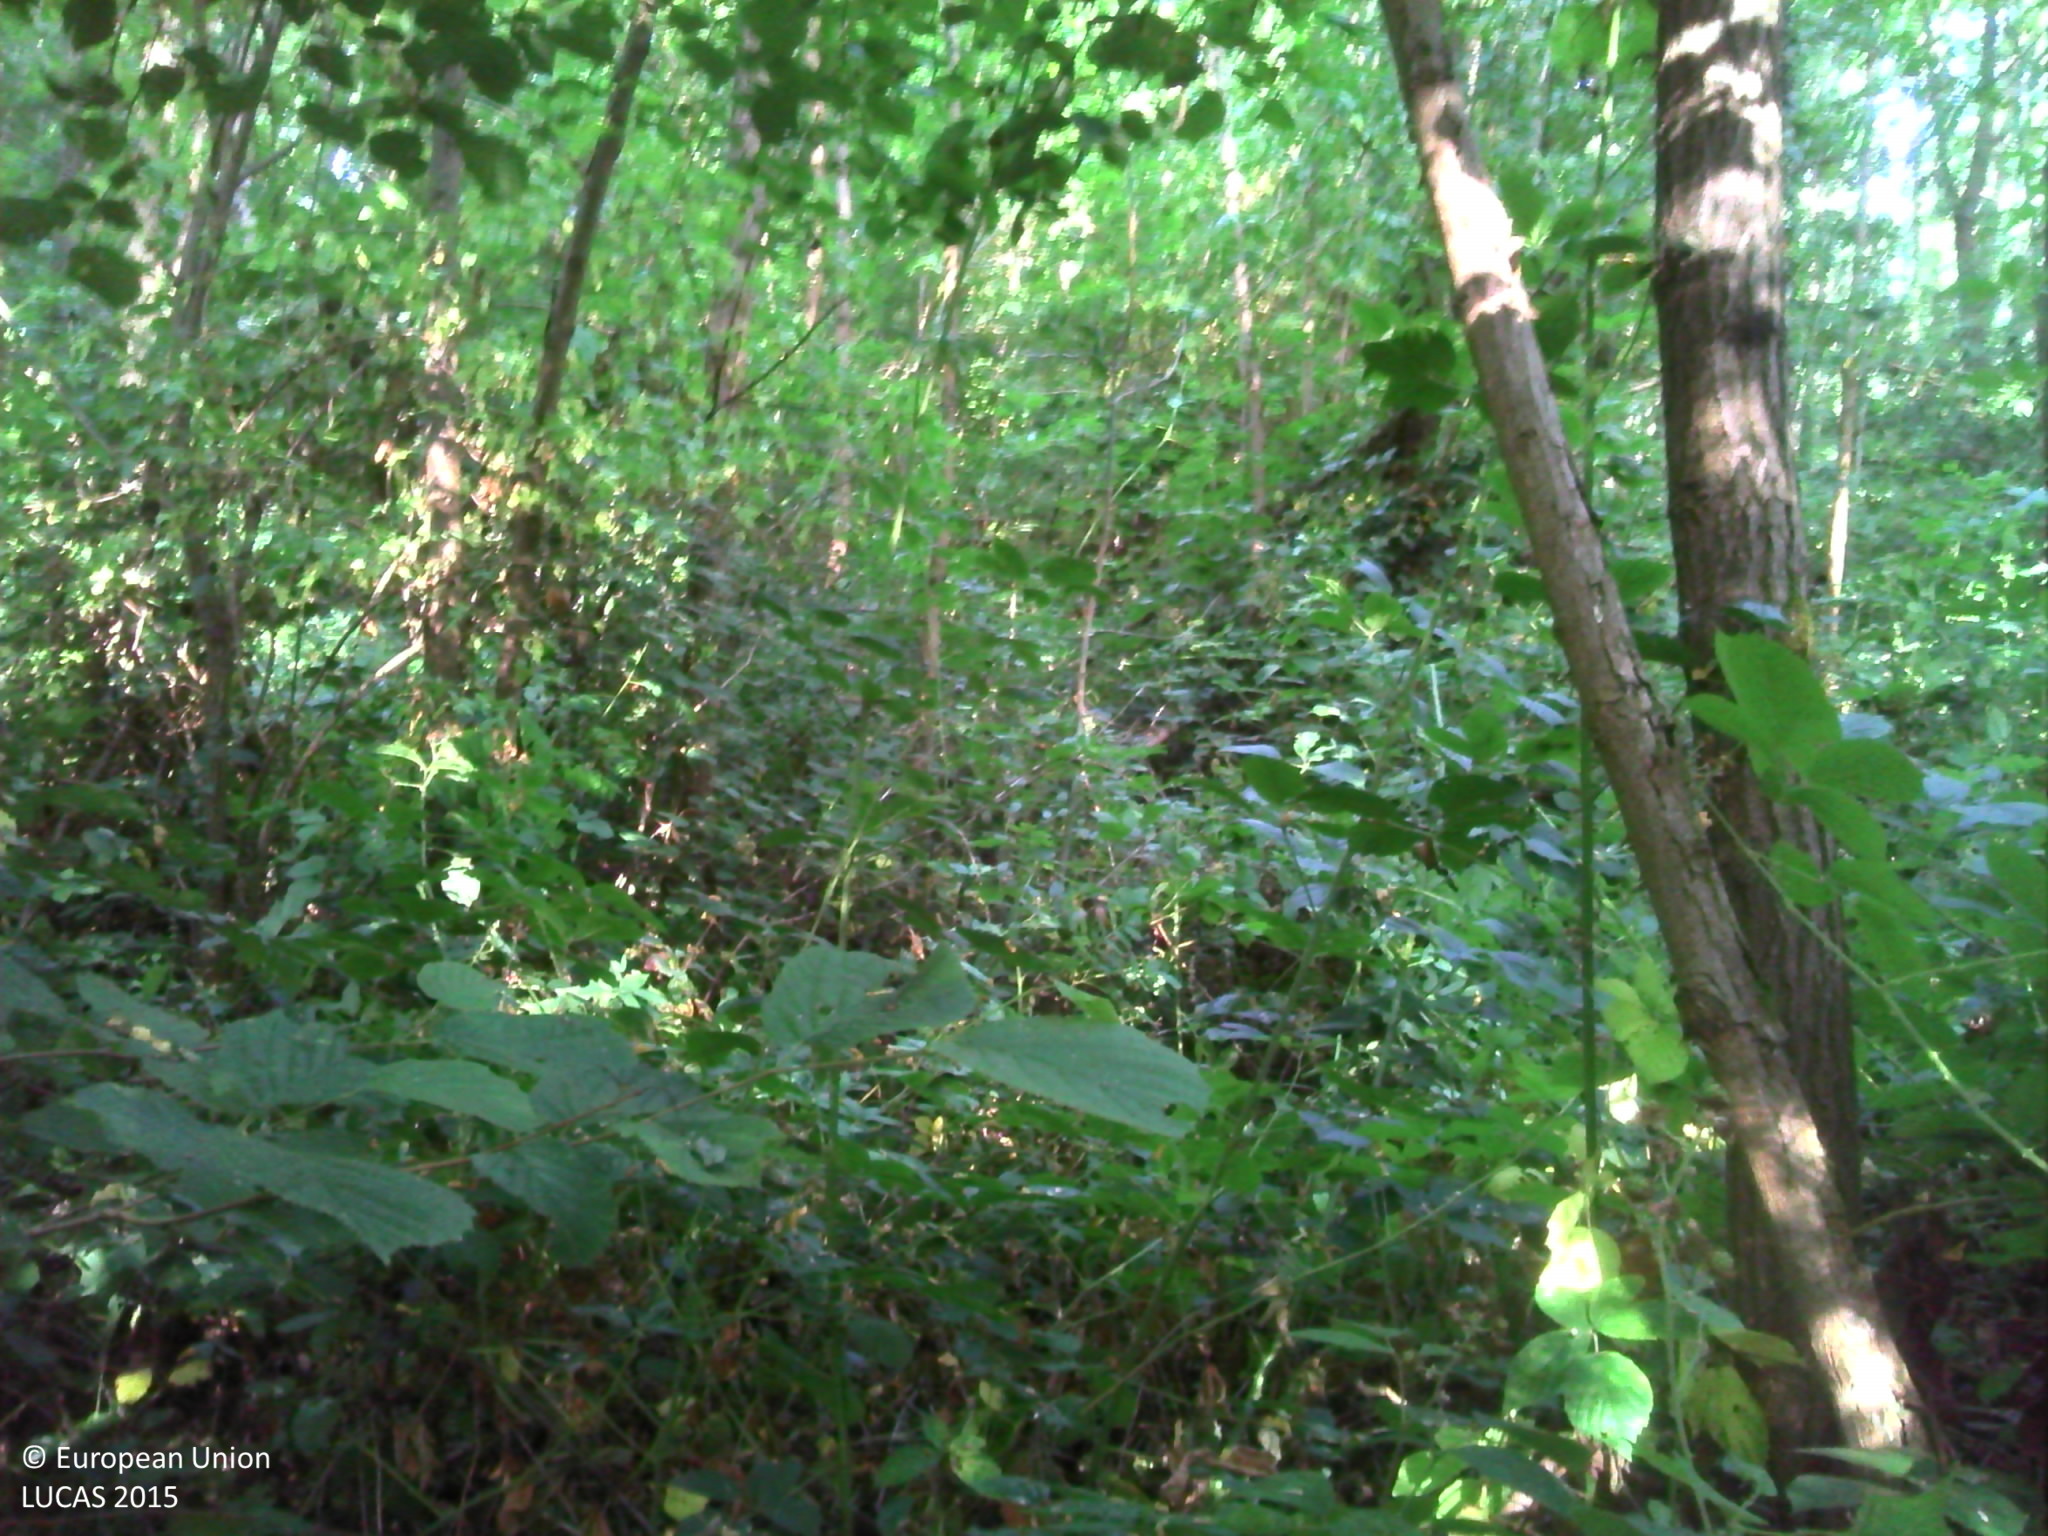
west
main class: Woodland
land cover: Broadleaved woodland
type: mesophytic deciduous forest
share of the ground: > 75 %
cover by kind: broadleaved forest trees 80 %, herbaceous plants 15 %, lichens and mosses 5 %
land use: Forestry
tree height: > 5 m
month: July
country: FR
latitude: 48.2413
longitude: 3.3825
